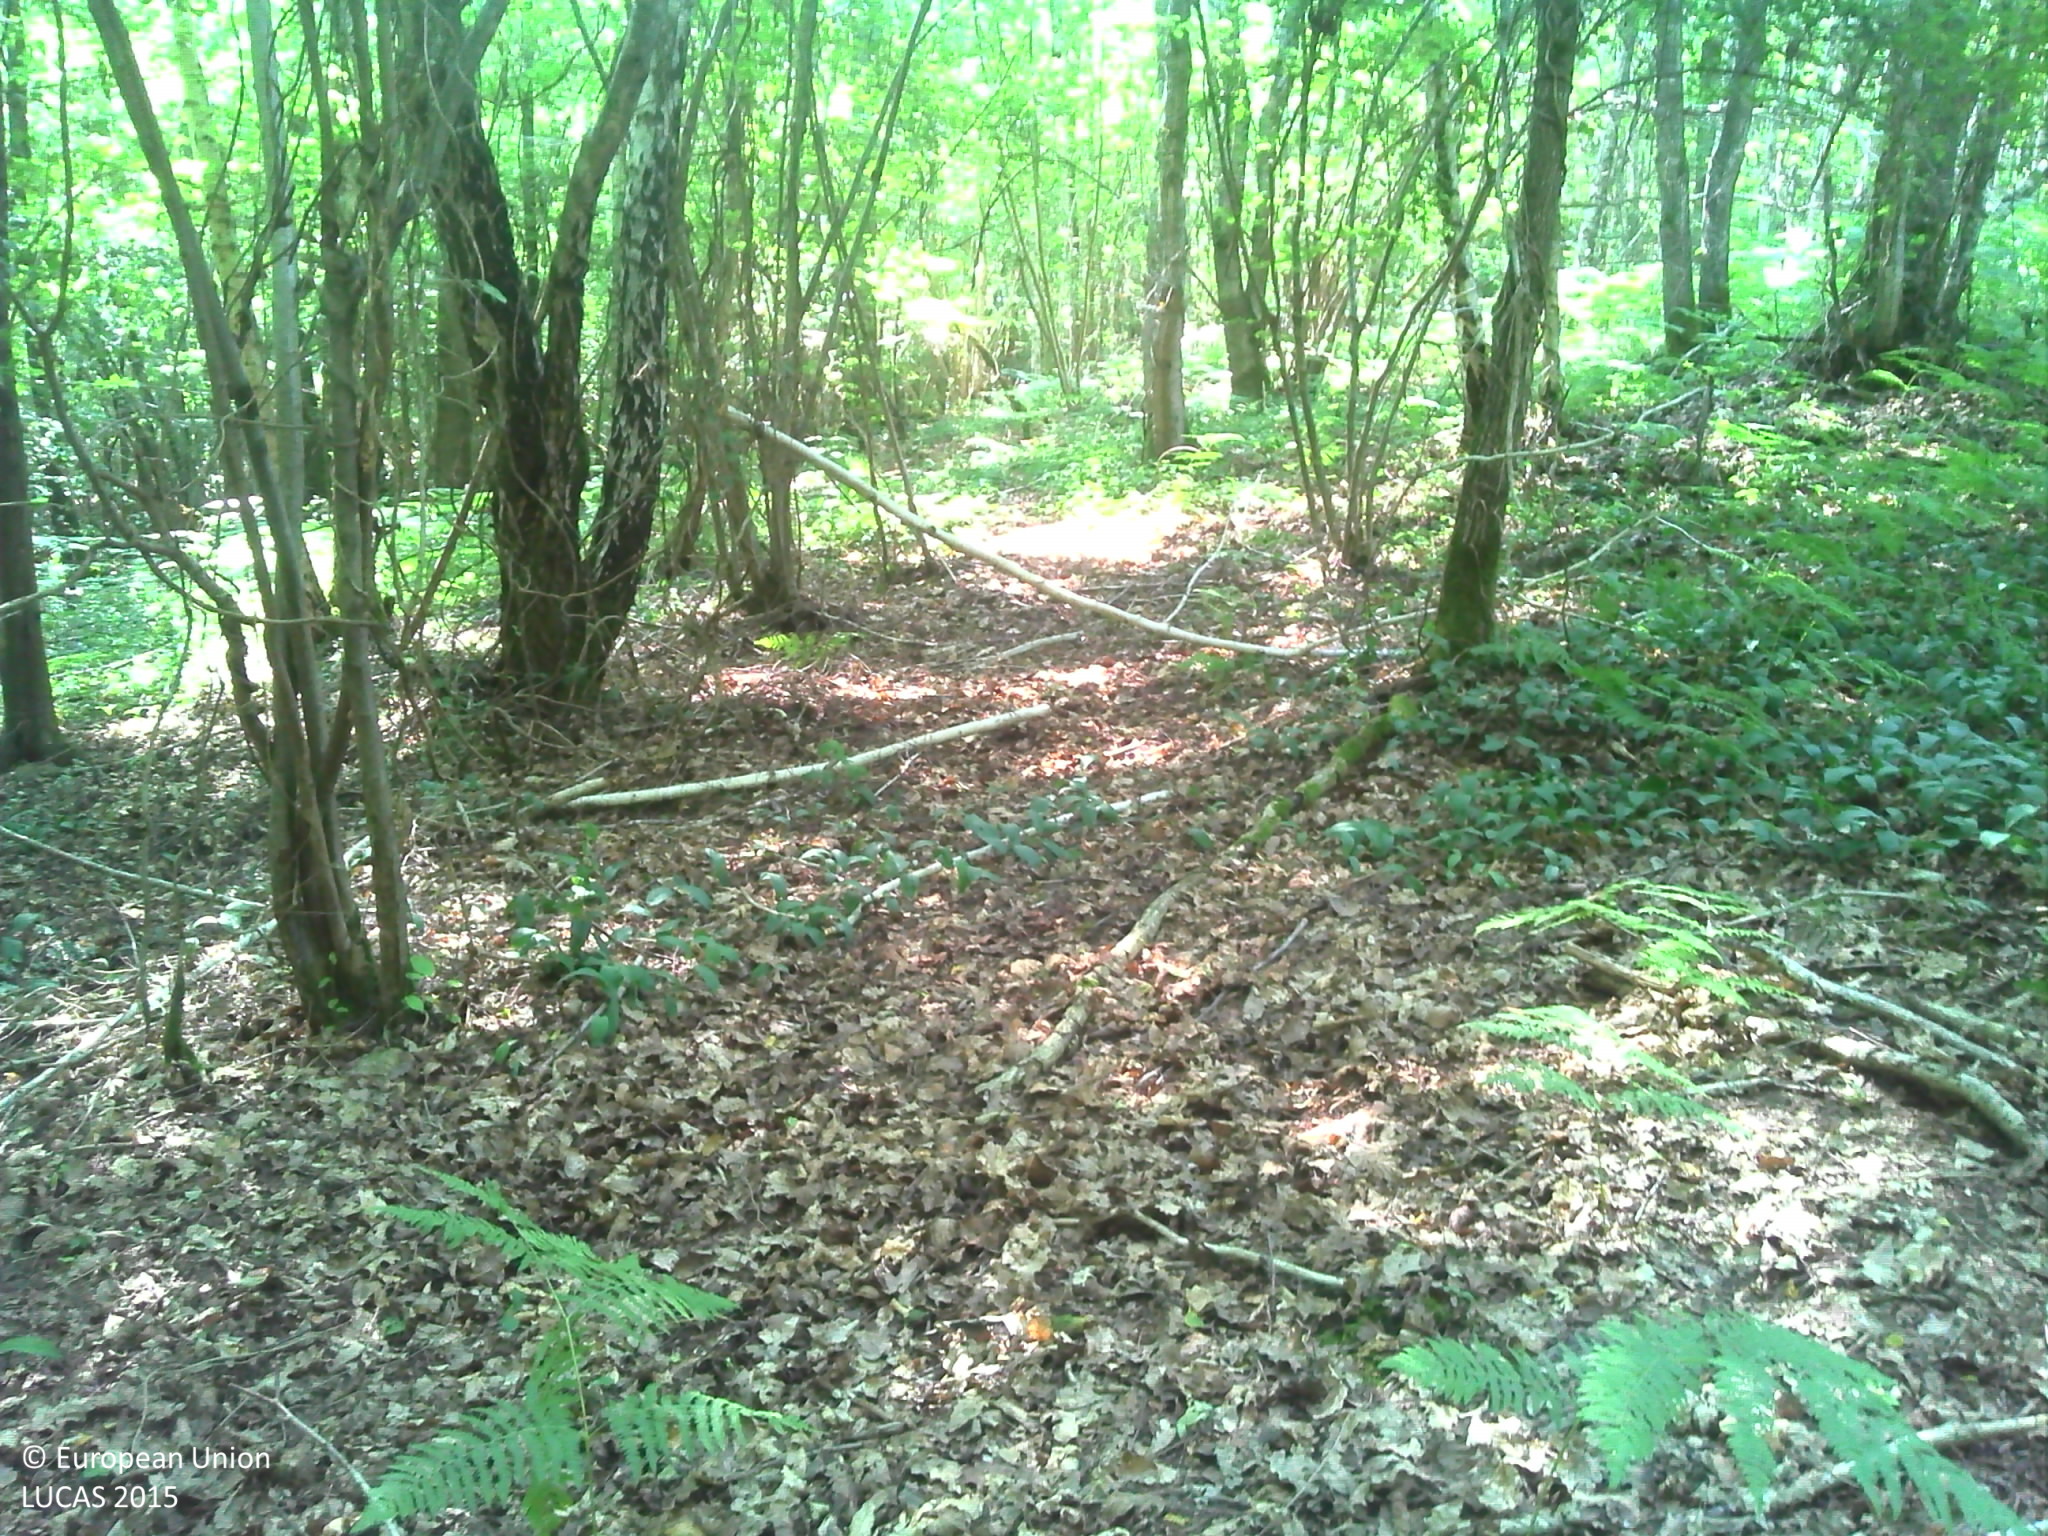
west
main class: Woodland
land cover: Broadleaved woodland
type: mesophytic deciduous forest
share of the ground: > 75 %
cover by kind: broadleaved forest trees 90 %, herbaceous plants 5 %, unconsolidated bare surface 5 %
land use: Forestry
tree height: > 5 m
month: July
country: FR
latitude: 49.0667
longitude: 3.2994
